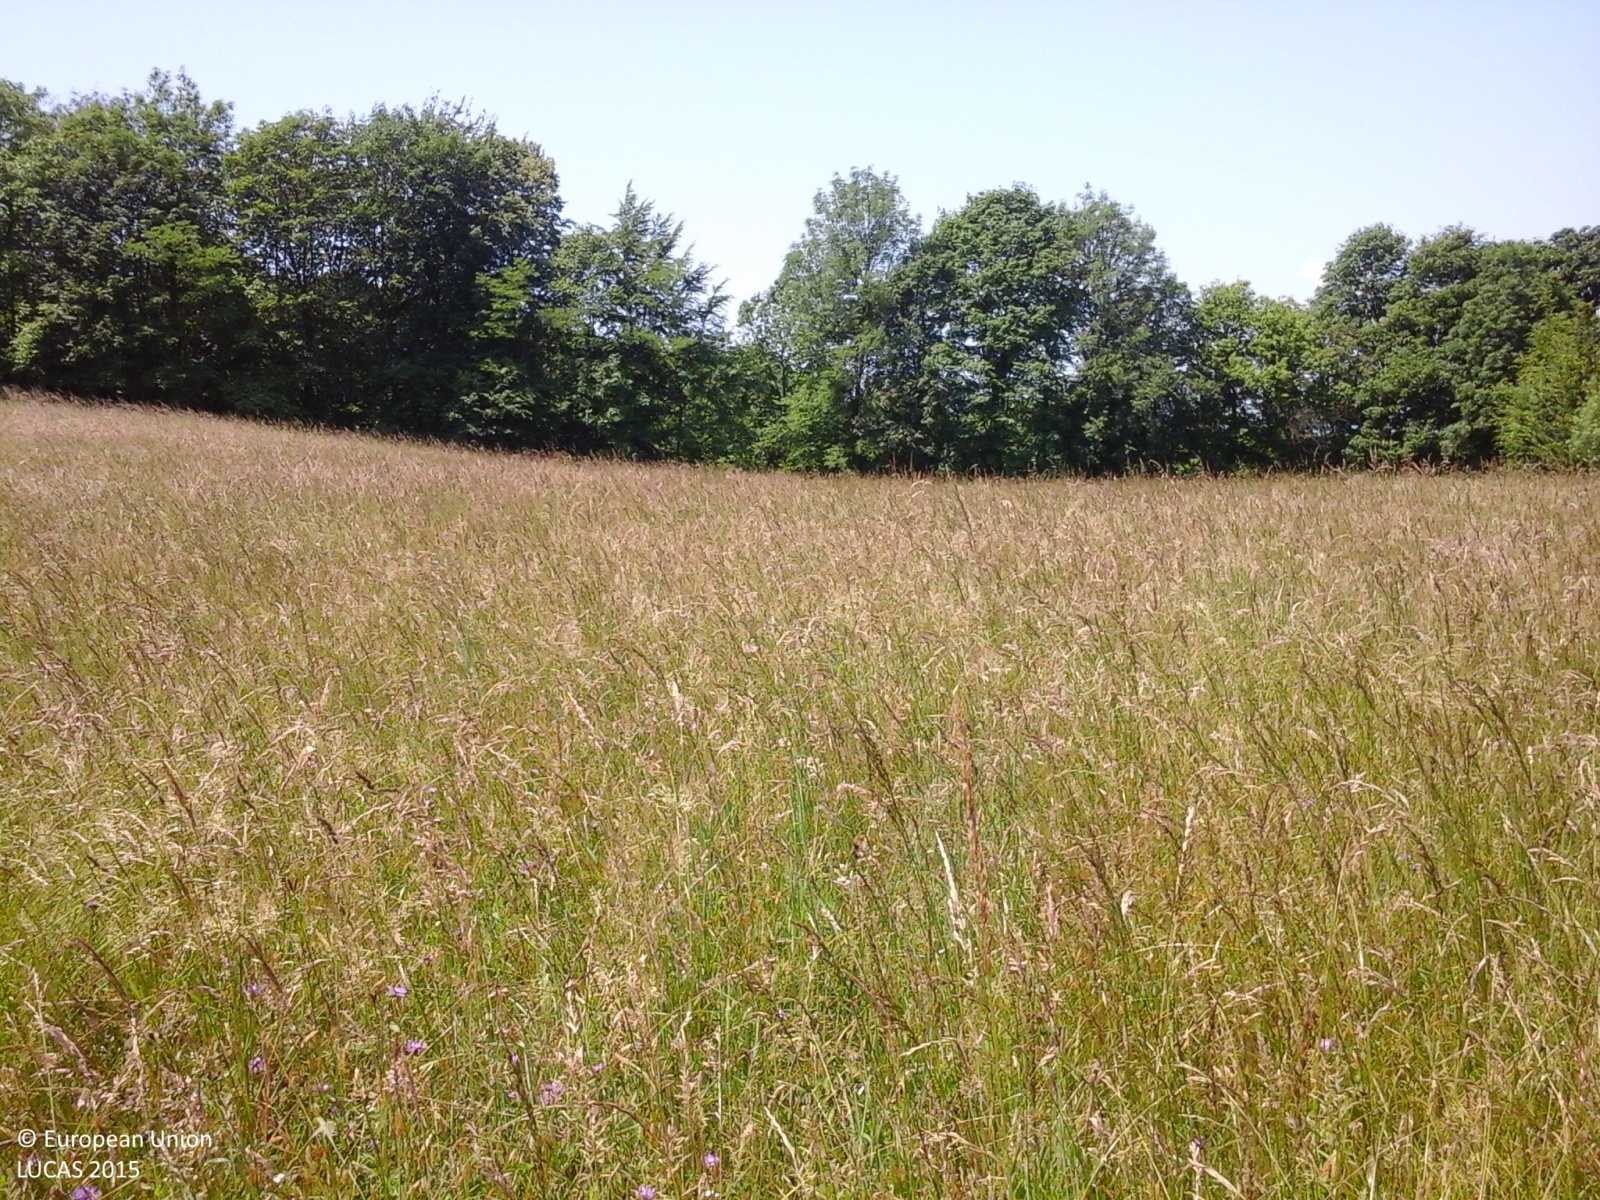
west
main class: Grassland
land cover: Grassland without tree/shrub cover
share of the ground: > 75 %
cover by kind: herbaceous plants 100 %
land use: Agriculture (excluding fallow land and kitchen gardens)
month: June
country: IT
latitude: 46.0597
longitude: 12.1300
